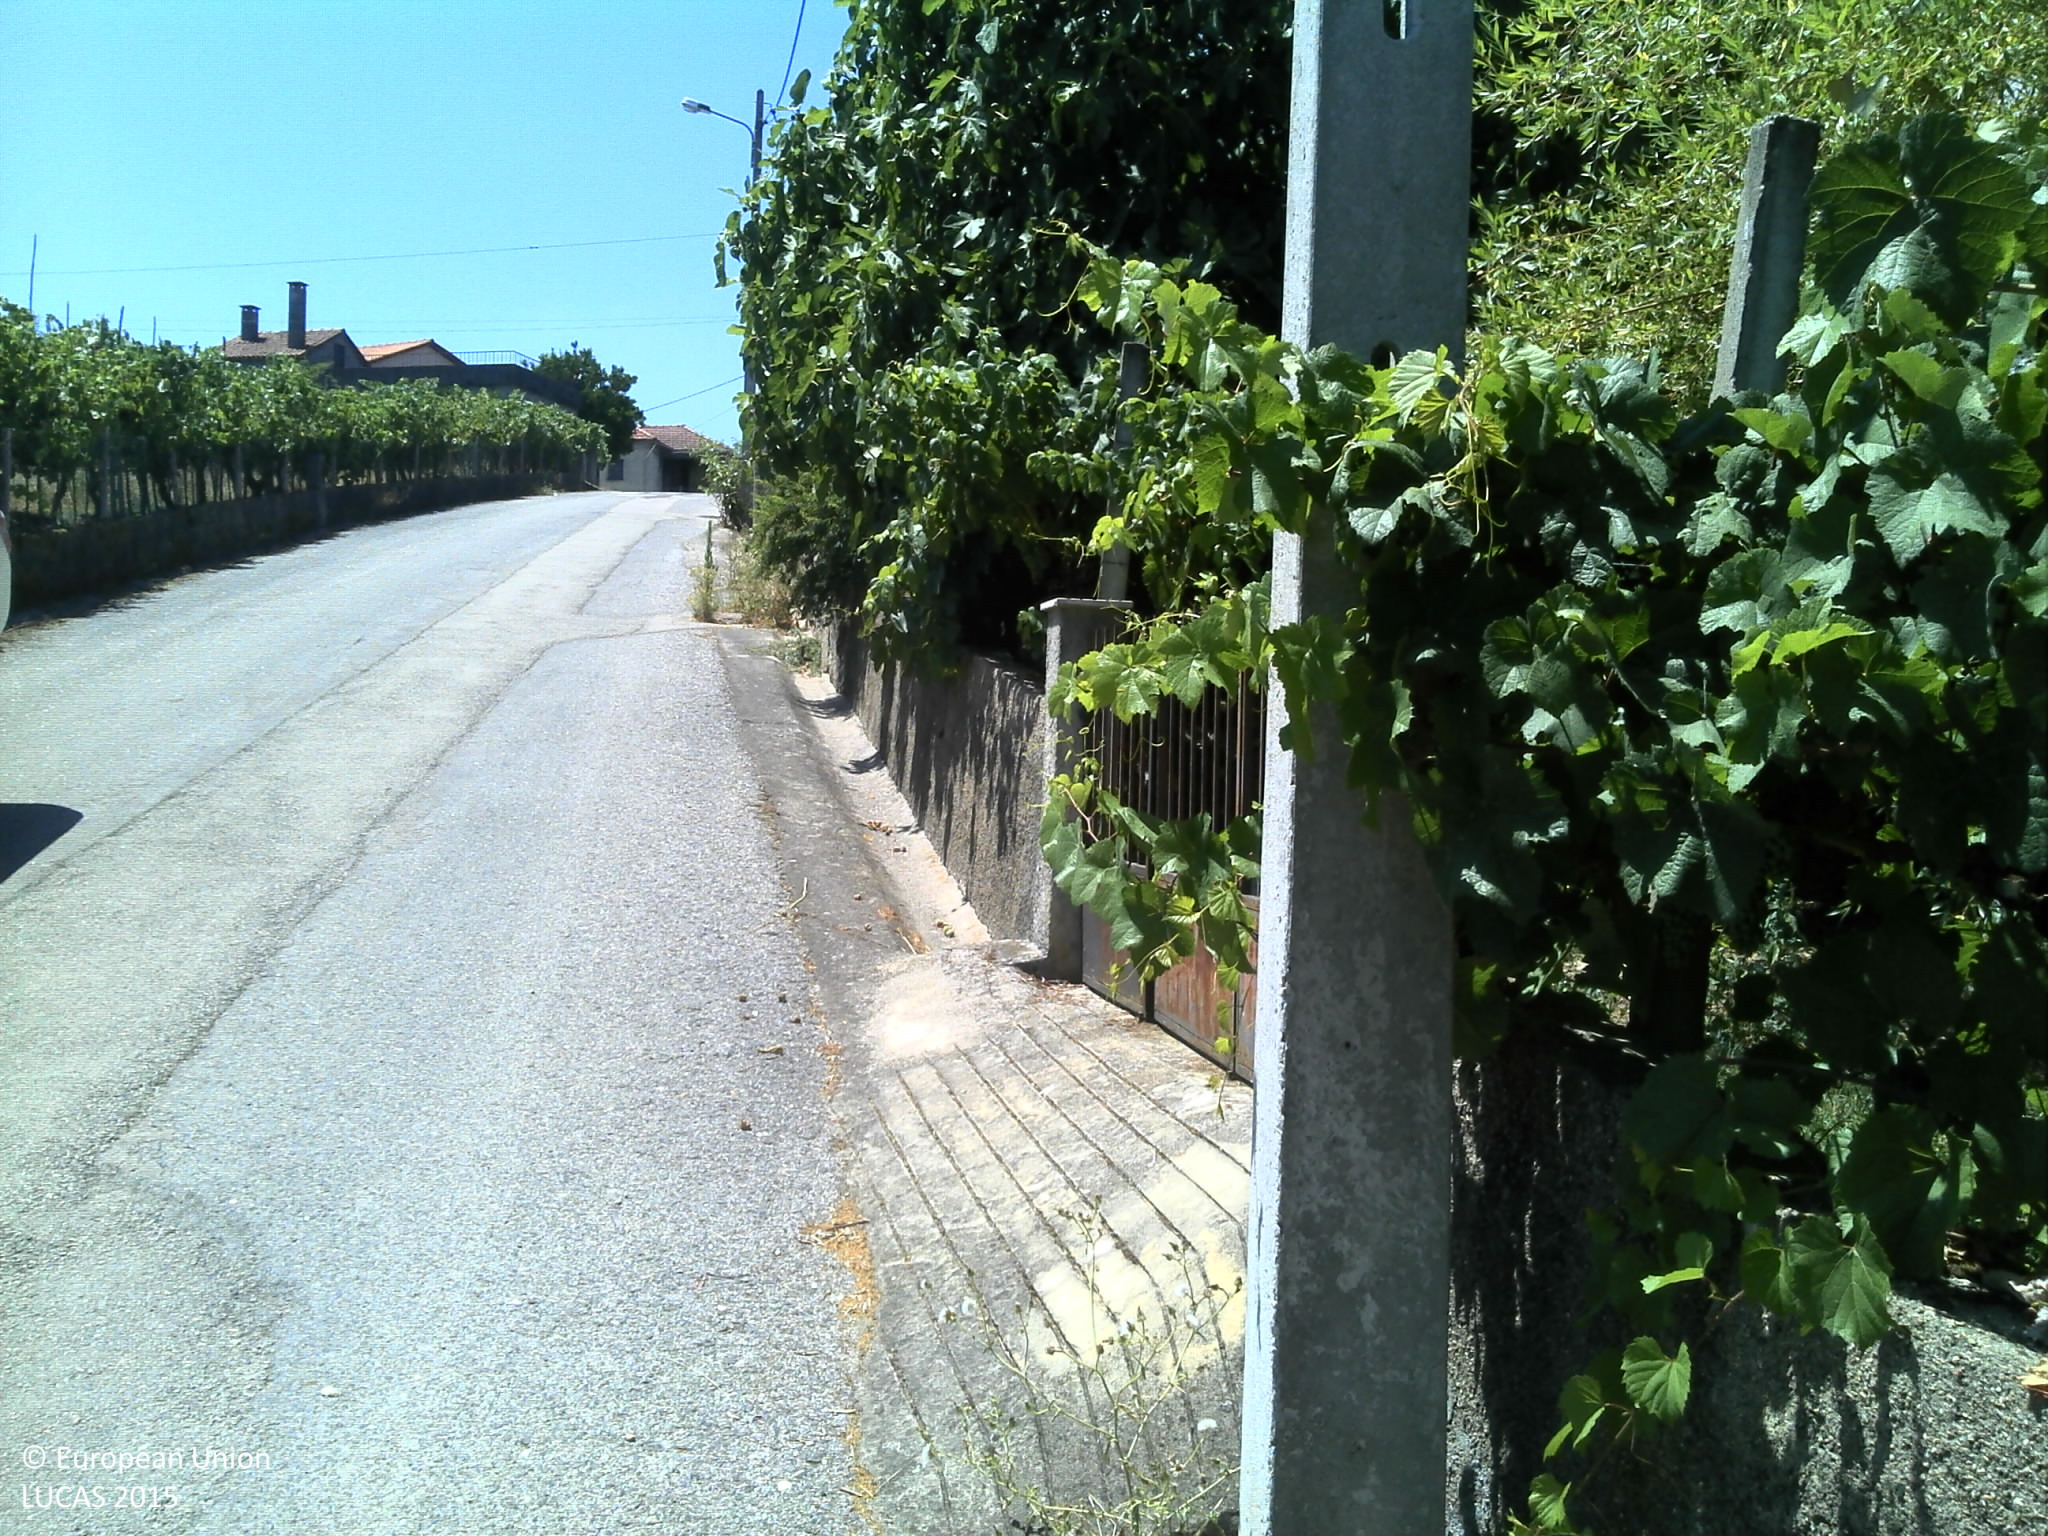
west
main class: Cropland
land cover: Olive groves
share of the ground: 10 - 25 %
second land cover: Grassland without tree/shrub cover
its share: 50 - 75 %
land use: Agriculture (excluding fallow land and kitchen gardens)
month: July
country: PT
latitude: 40.3250
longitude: -8.1919
